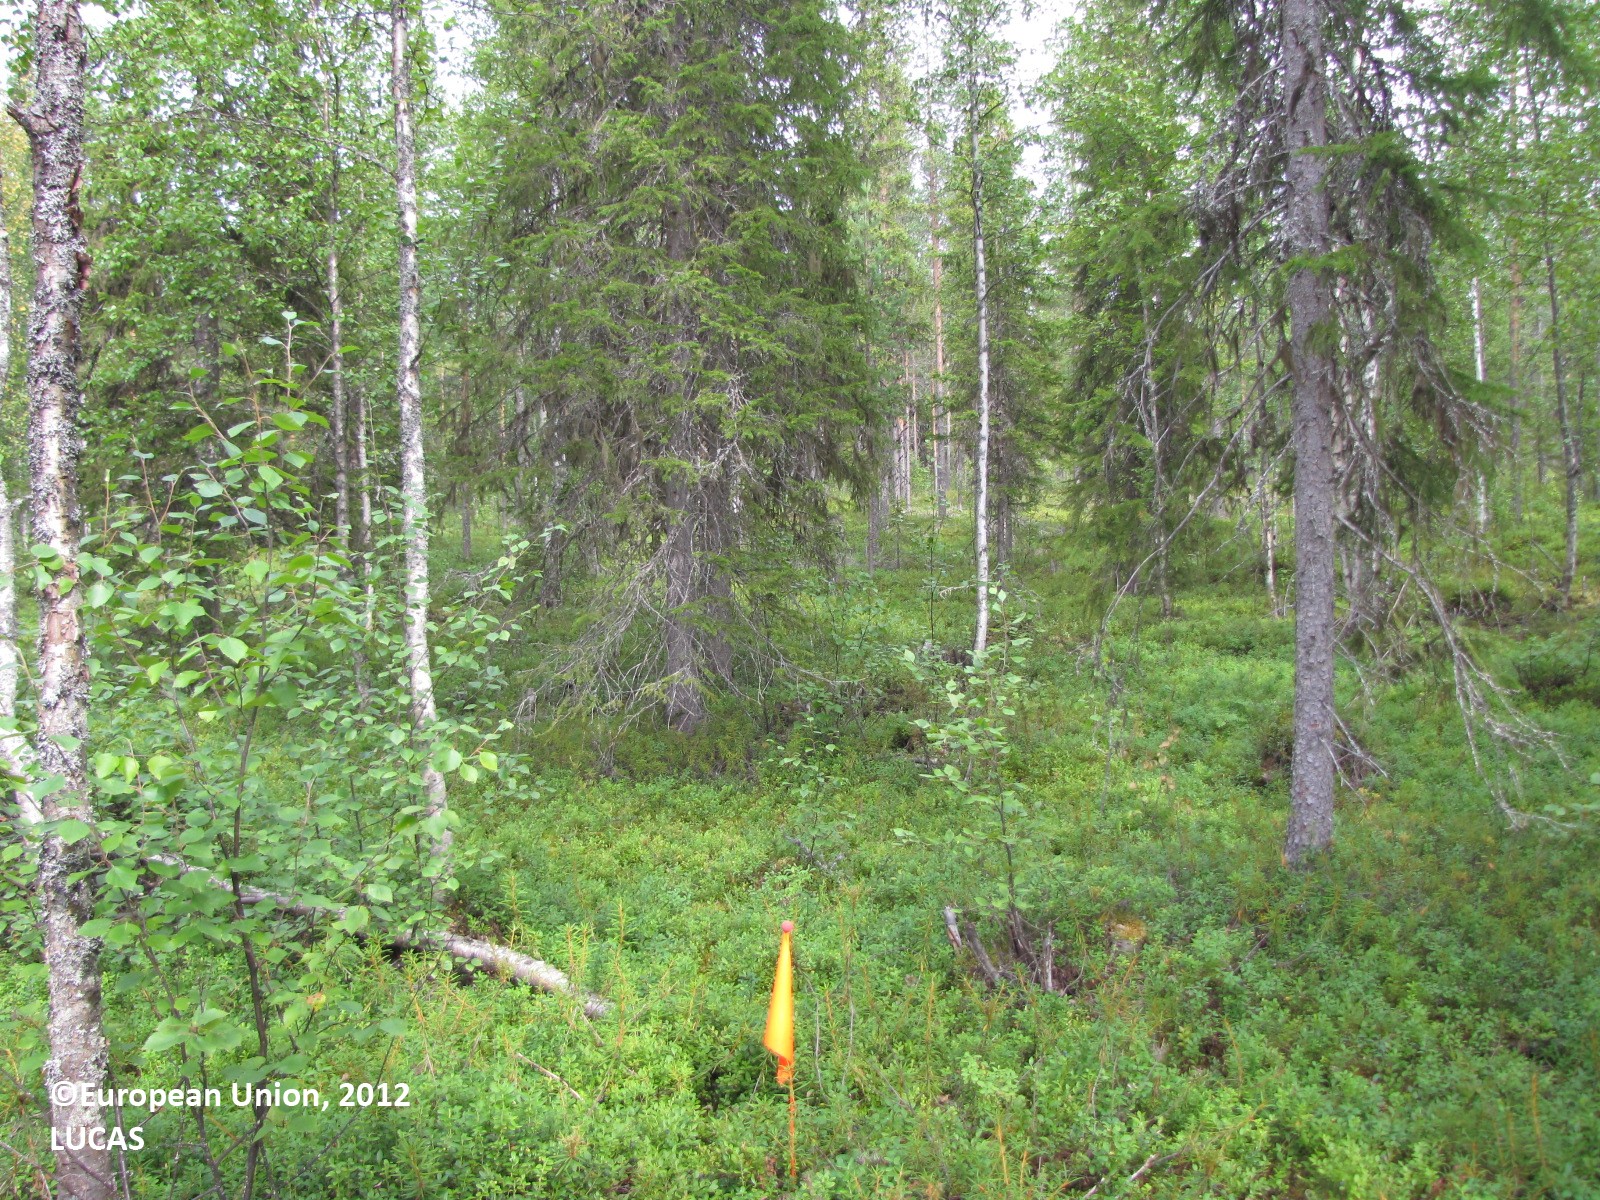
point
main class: Woodland
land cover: Other mixed woodland
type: boreal forest
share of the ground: 10 - 25 %
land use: Forestry
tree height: > 5 m
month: August
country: FI
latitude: 66.8508
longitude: 24.8863
